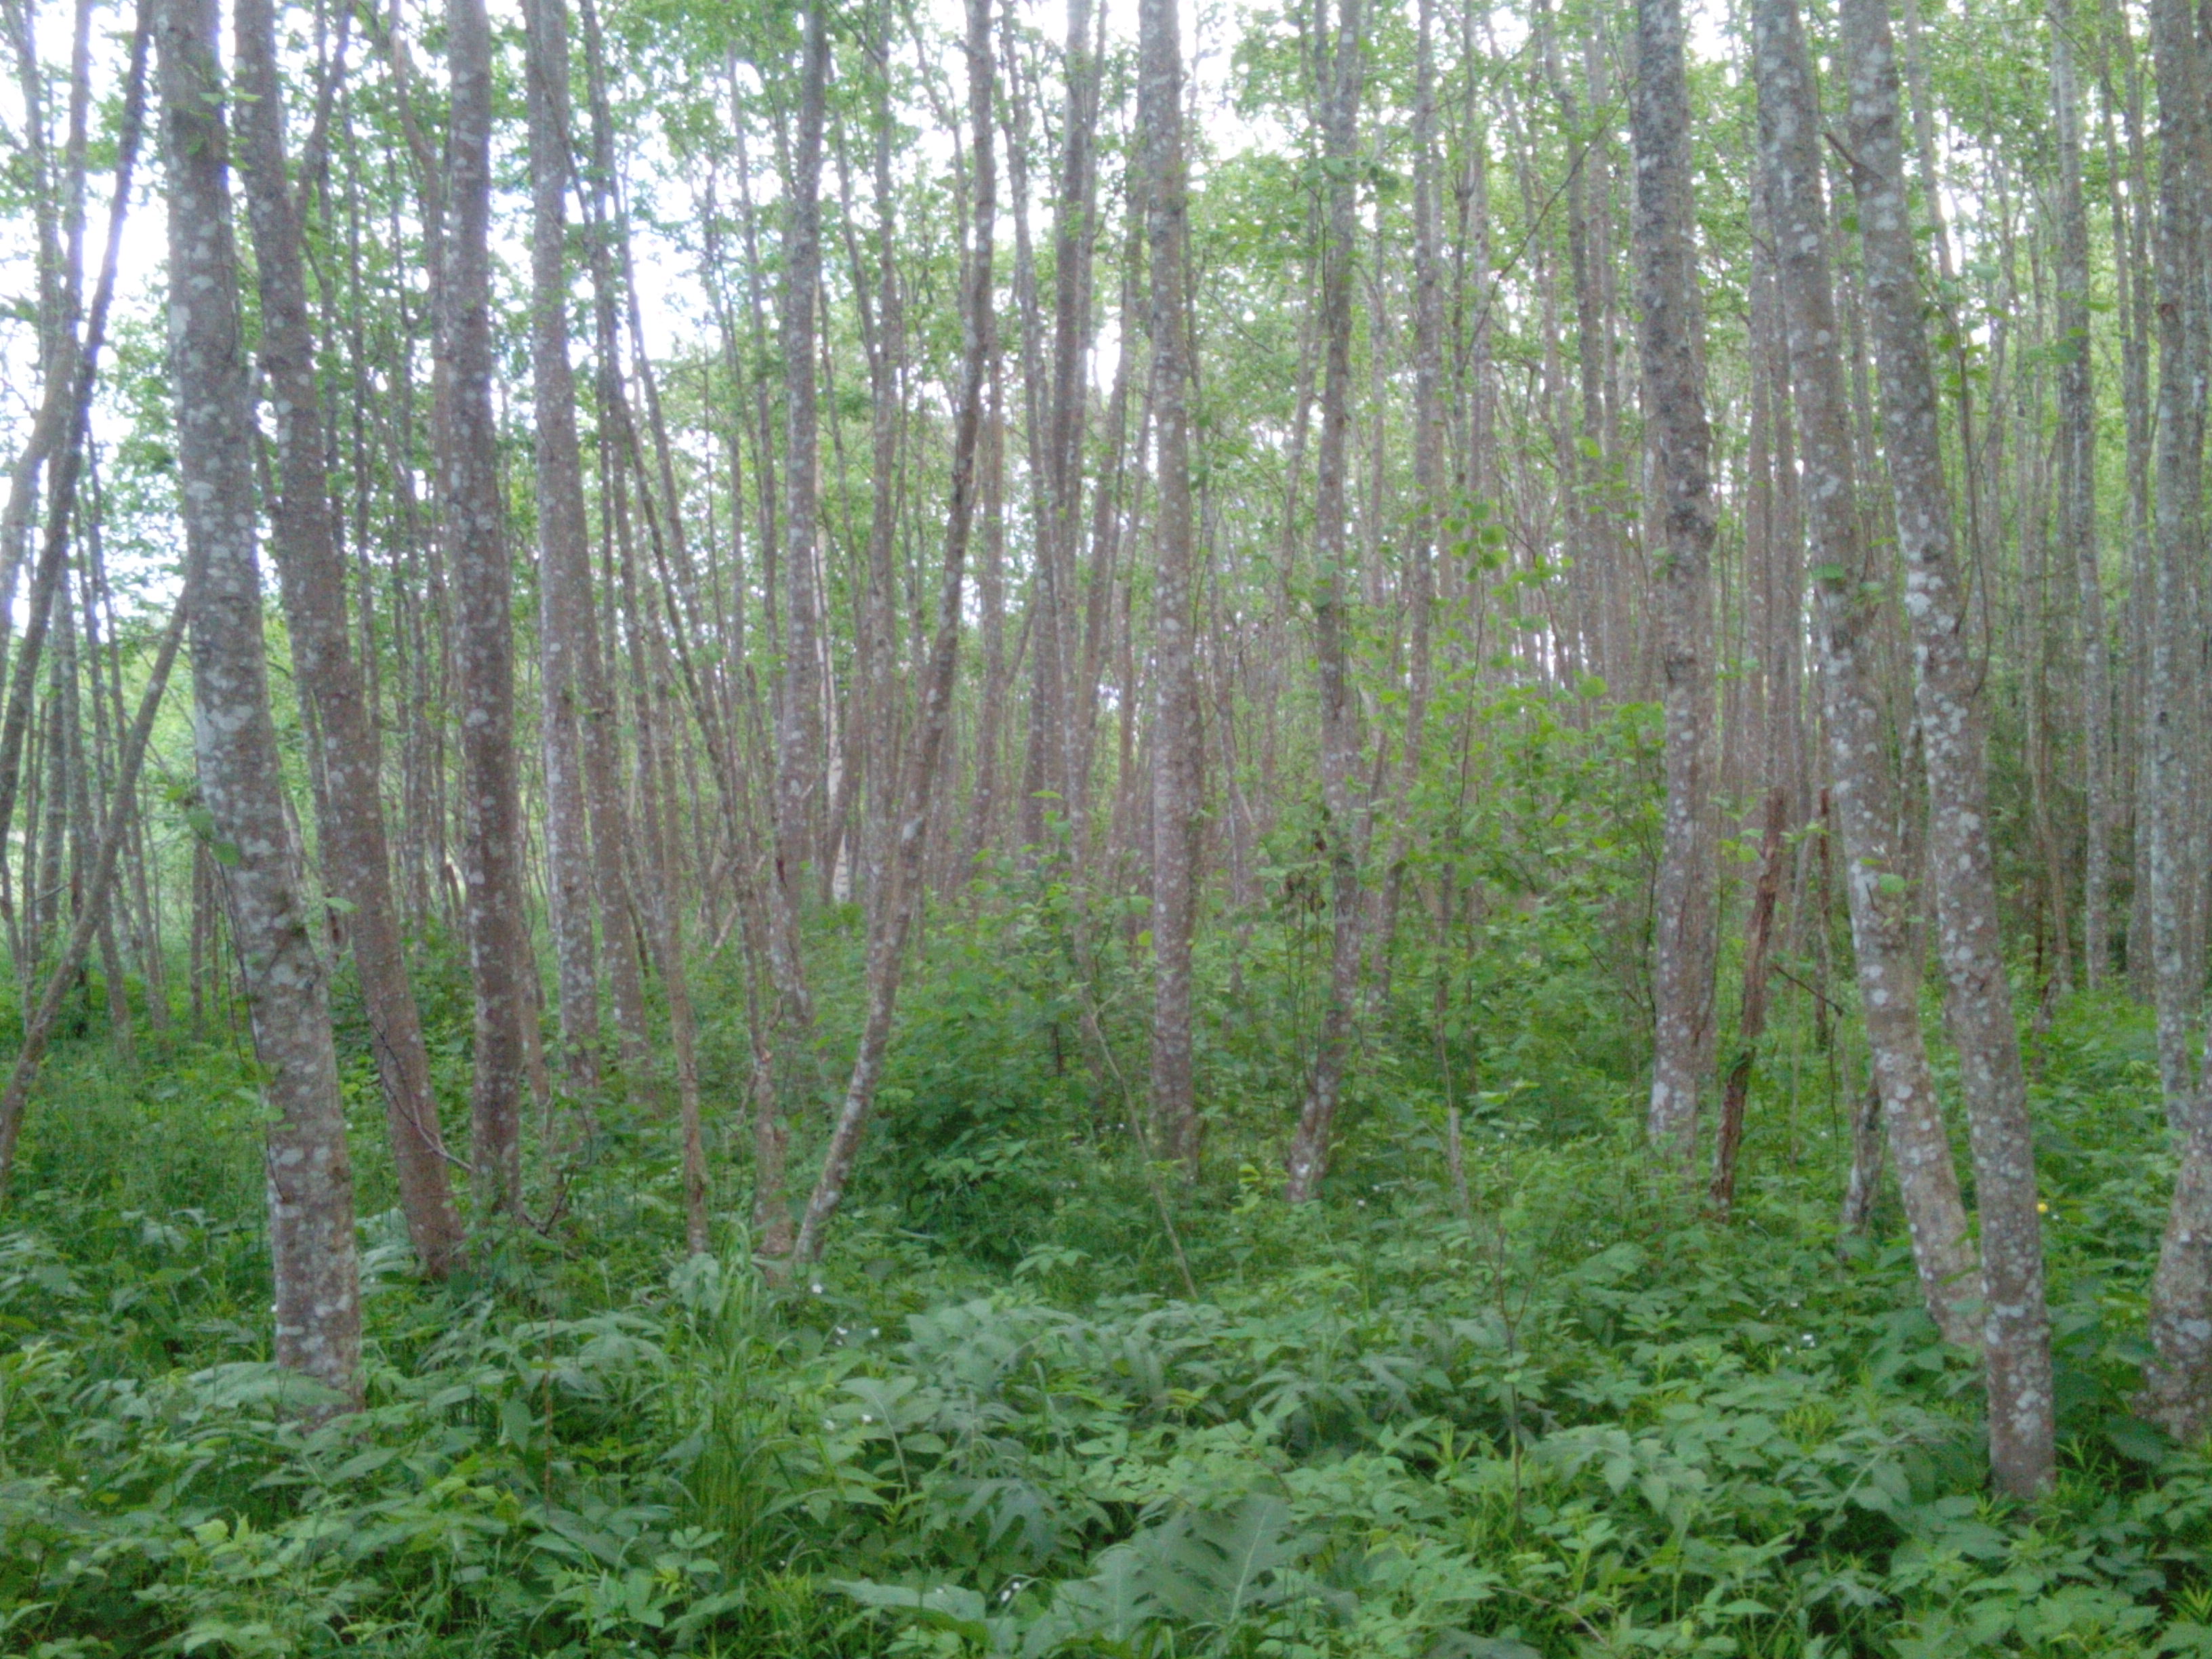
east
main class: Woodland
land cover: Broadleaved woodland
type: non-riverine alder, birch or aspen forest
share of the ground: > 75 %
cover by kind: broadleaved forest trees 80 %, herbaceous plants 10 %, coniferous forest trees 5 %, shrubs 5 %
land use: Forestry
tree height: > 5 m
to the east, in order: Broadleaved woodland; Spontaneously vegetated surfaces; Shrubland without tree cover; Shruby margins; Ditches and canals; Spontaneously vegetated surfaces; Ditches and canals; Inland marshes; Broadleaved woodland; Spruce dominated mixed woodland
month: June
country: LV
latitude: 56.7439
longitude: 22.2663
